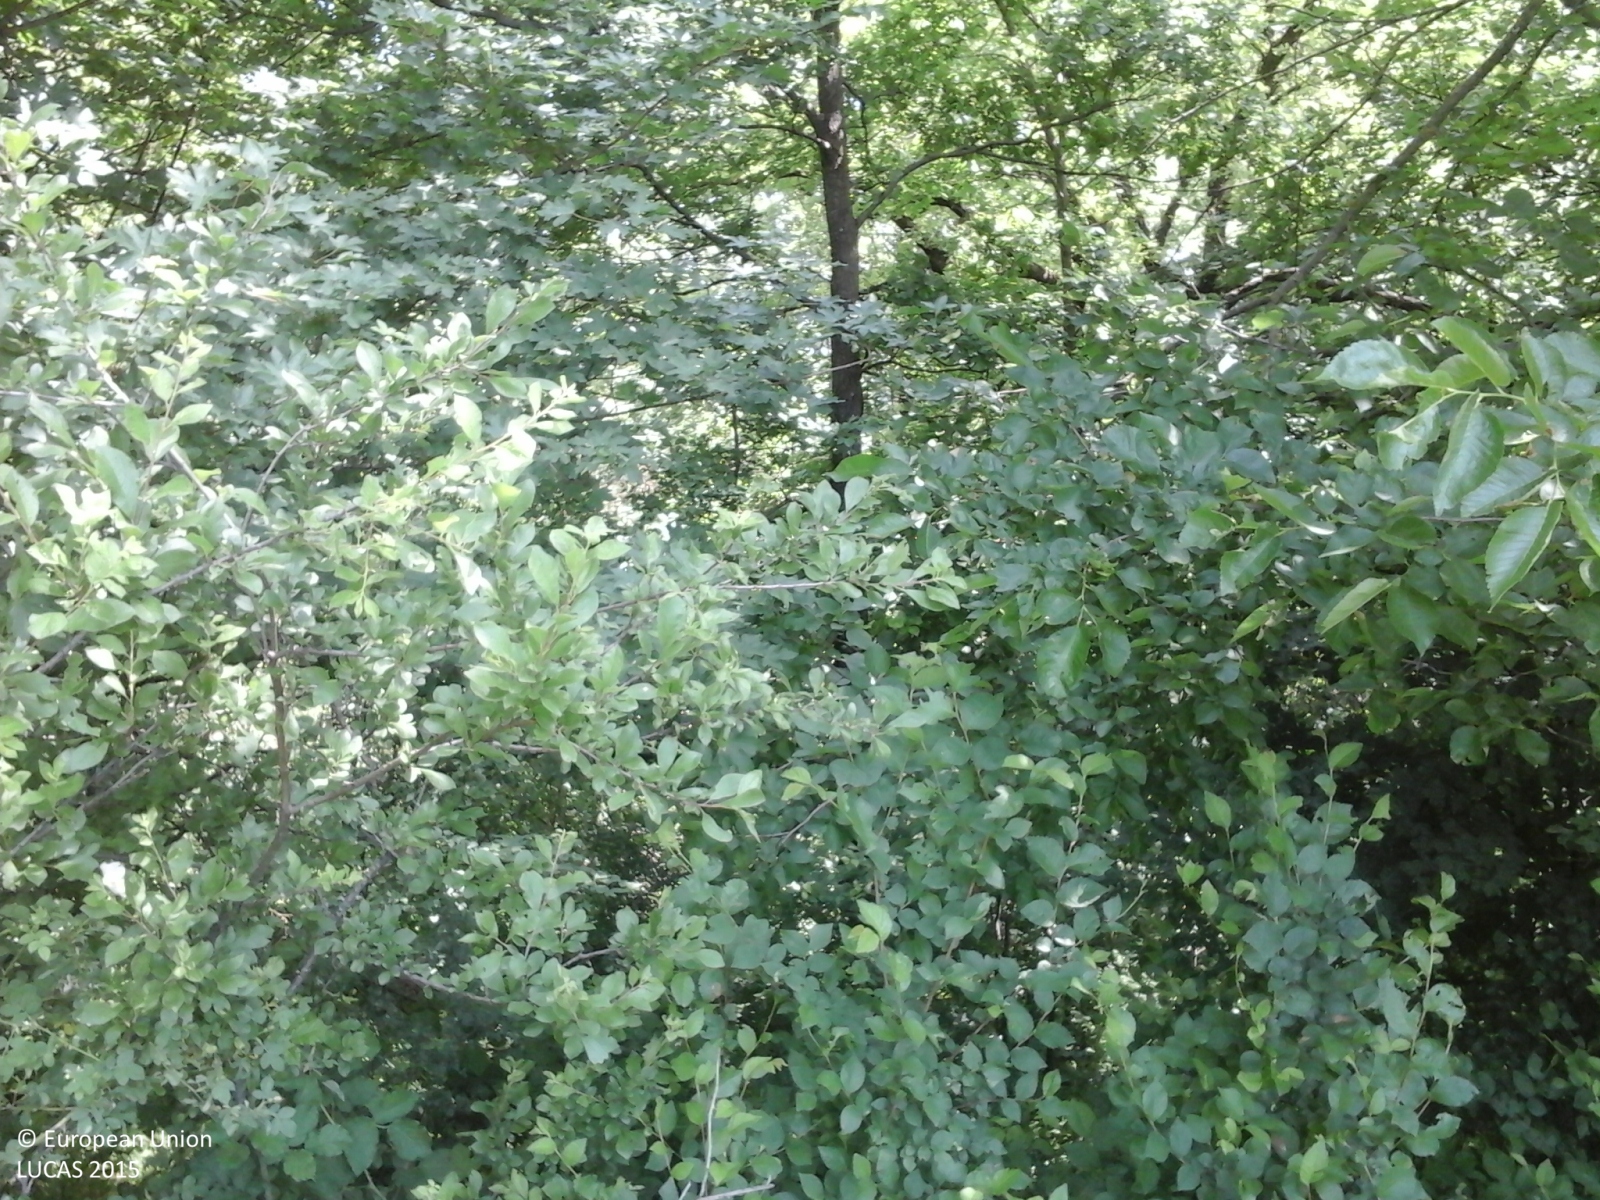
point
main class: Woodland
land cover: Broadleaved woodland
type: thermophilous deciduous forest
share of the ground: > 75 %
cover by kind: broadleaved forest trees 100 %
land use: Forestry
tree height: > 5 m
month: May
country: IT
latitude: 44.3832
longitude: 10.8391
